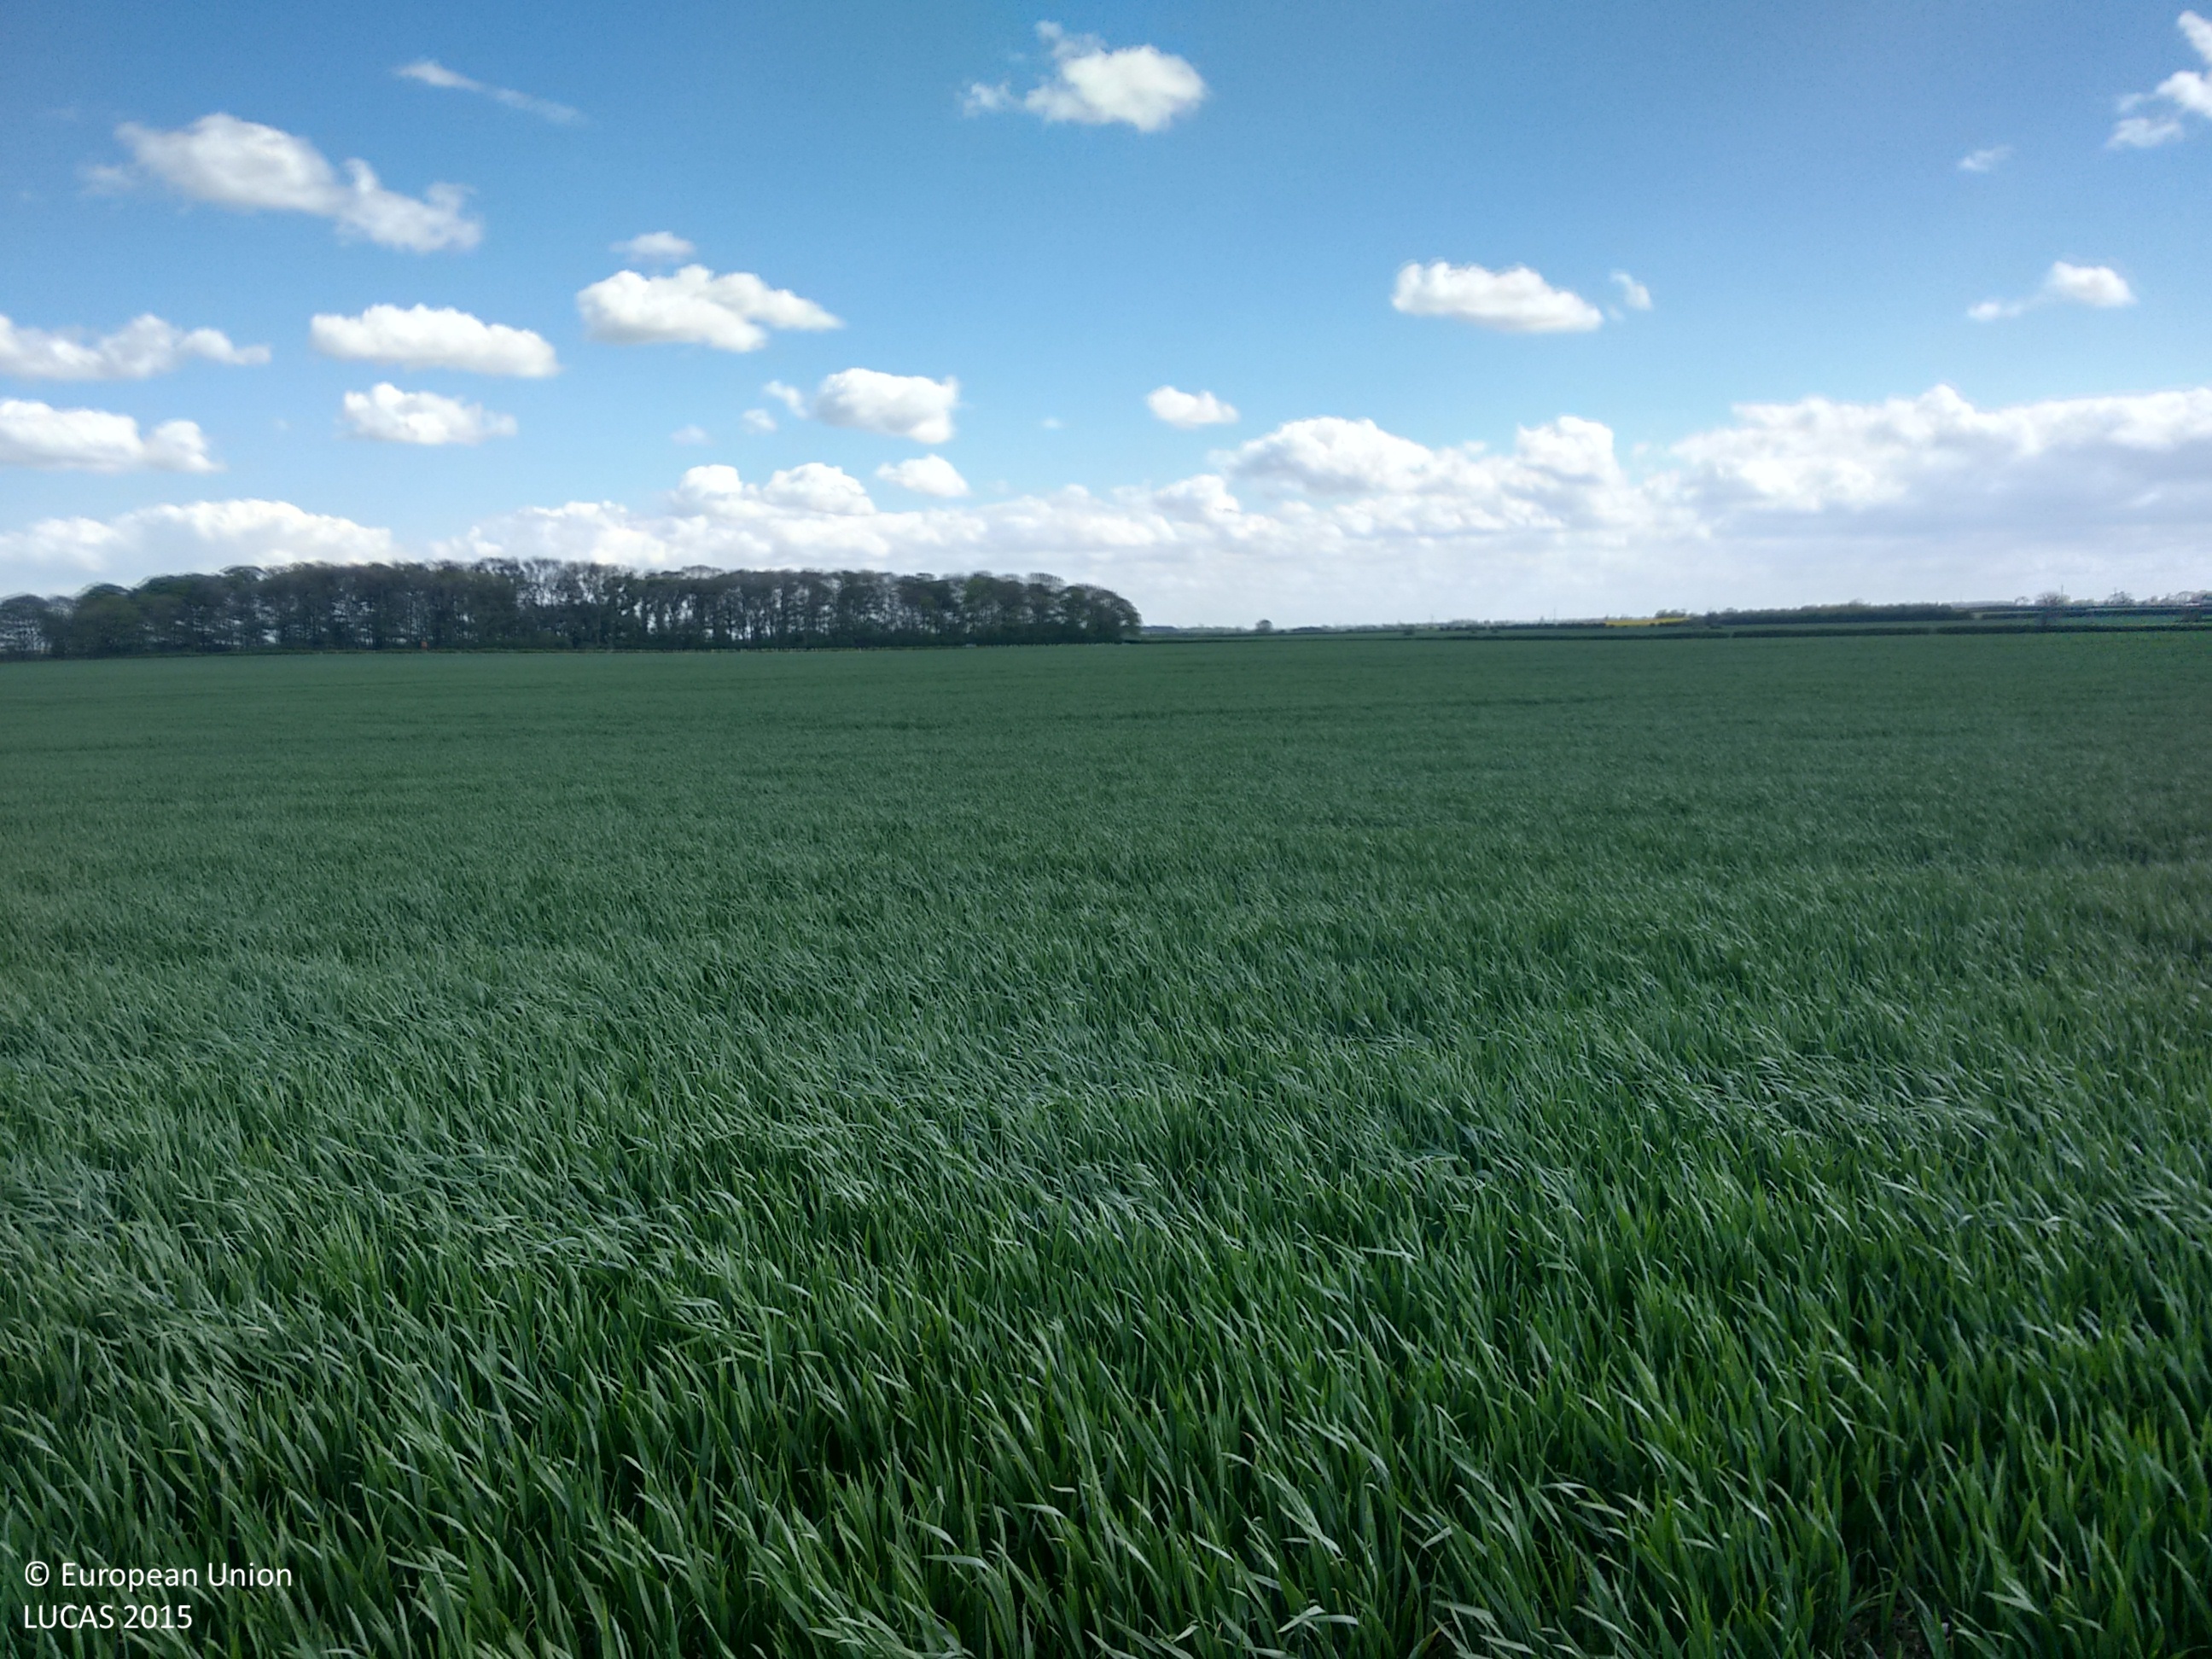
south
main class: Cropland
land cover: Common wheat
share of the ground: > 75 %
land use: Agriculture (excluding fallow land and kitchen gardens)
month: May
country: GB
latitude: 53.8655
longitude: -0.3297
